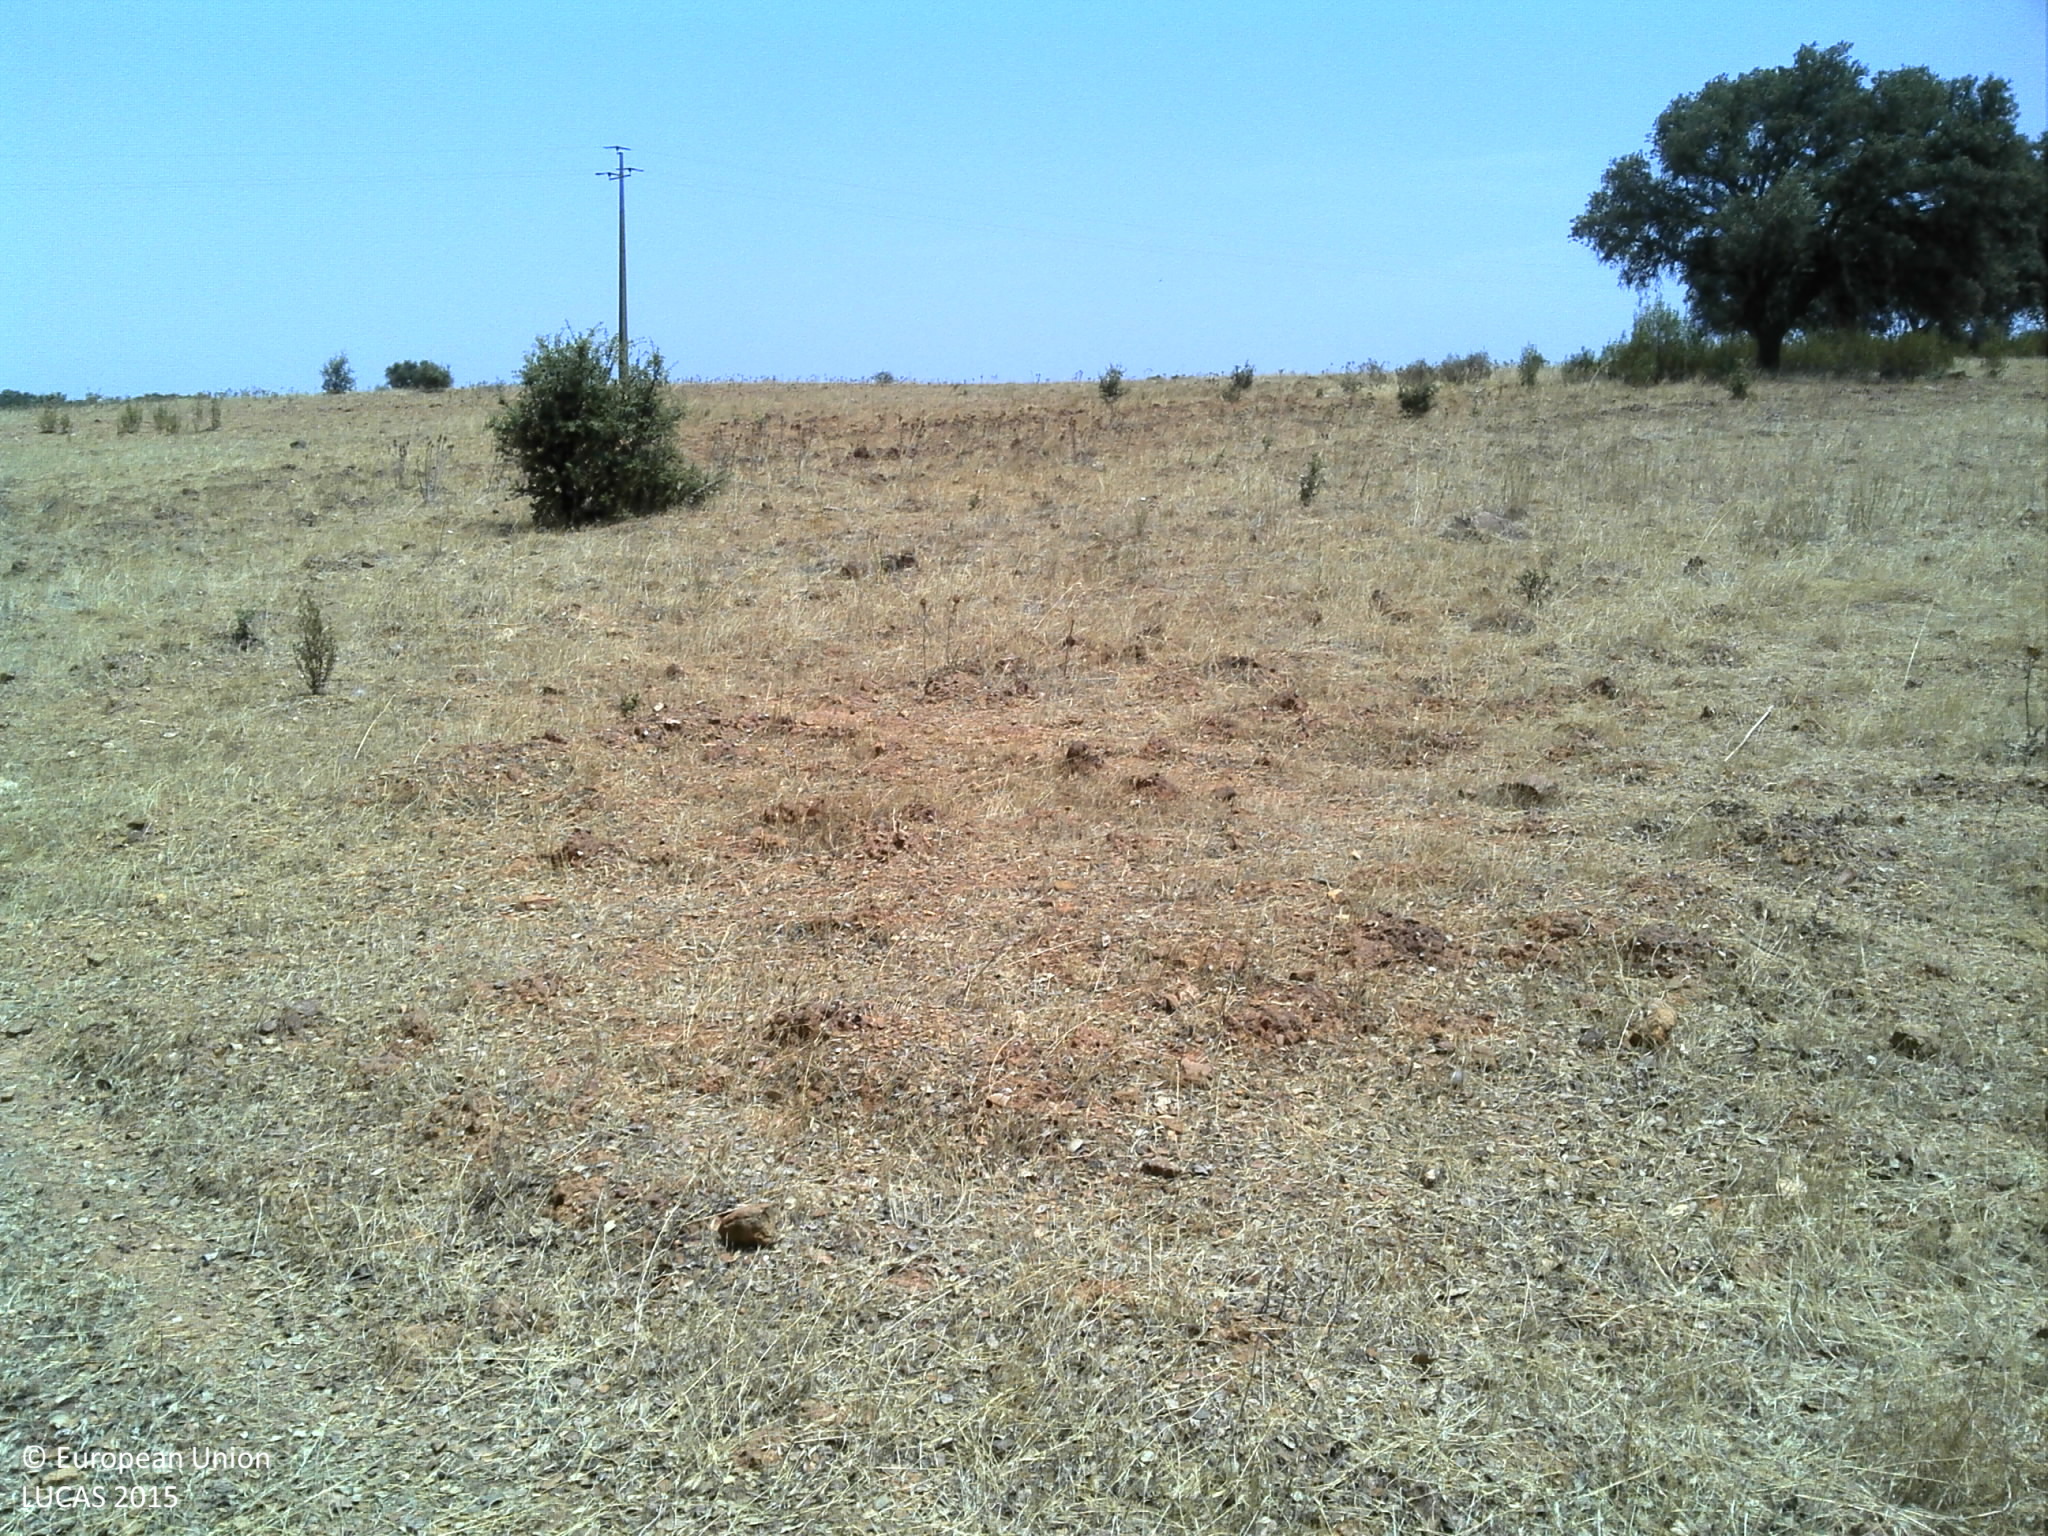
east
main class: Woodland
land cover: Broadleaved woodland
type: broadleaved evergreen forest
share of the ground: 10 - 25 %
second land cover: Grassland without tree/shrub cover
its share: 10 - 25 %
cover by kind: unconsolidated bare surface 55 %, herbaceous plants 25 %, broadleaved forest trees 10 %, shrubs 5 %
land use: Forestry
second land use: Agriculture (excluding fallow land and kitchen gardens)
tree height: > 5 m
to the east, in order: Broadleaved woodland; Grassland without tree/shrub cover; Broadleaved woodland; Grassland without tree/shrub cover; Grassland with sparse tree/shrub cover; Electric lines; Grassland with sparse tree/shrub cover
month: July
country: PT
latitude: 37.7236
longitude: -7.7755
